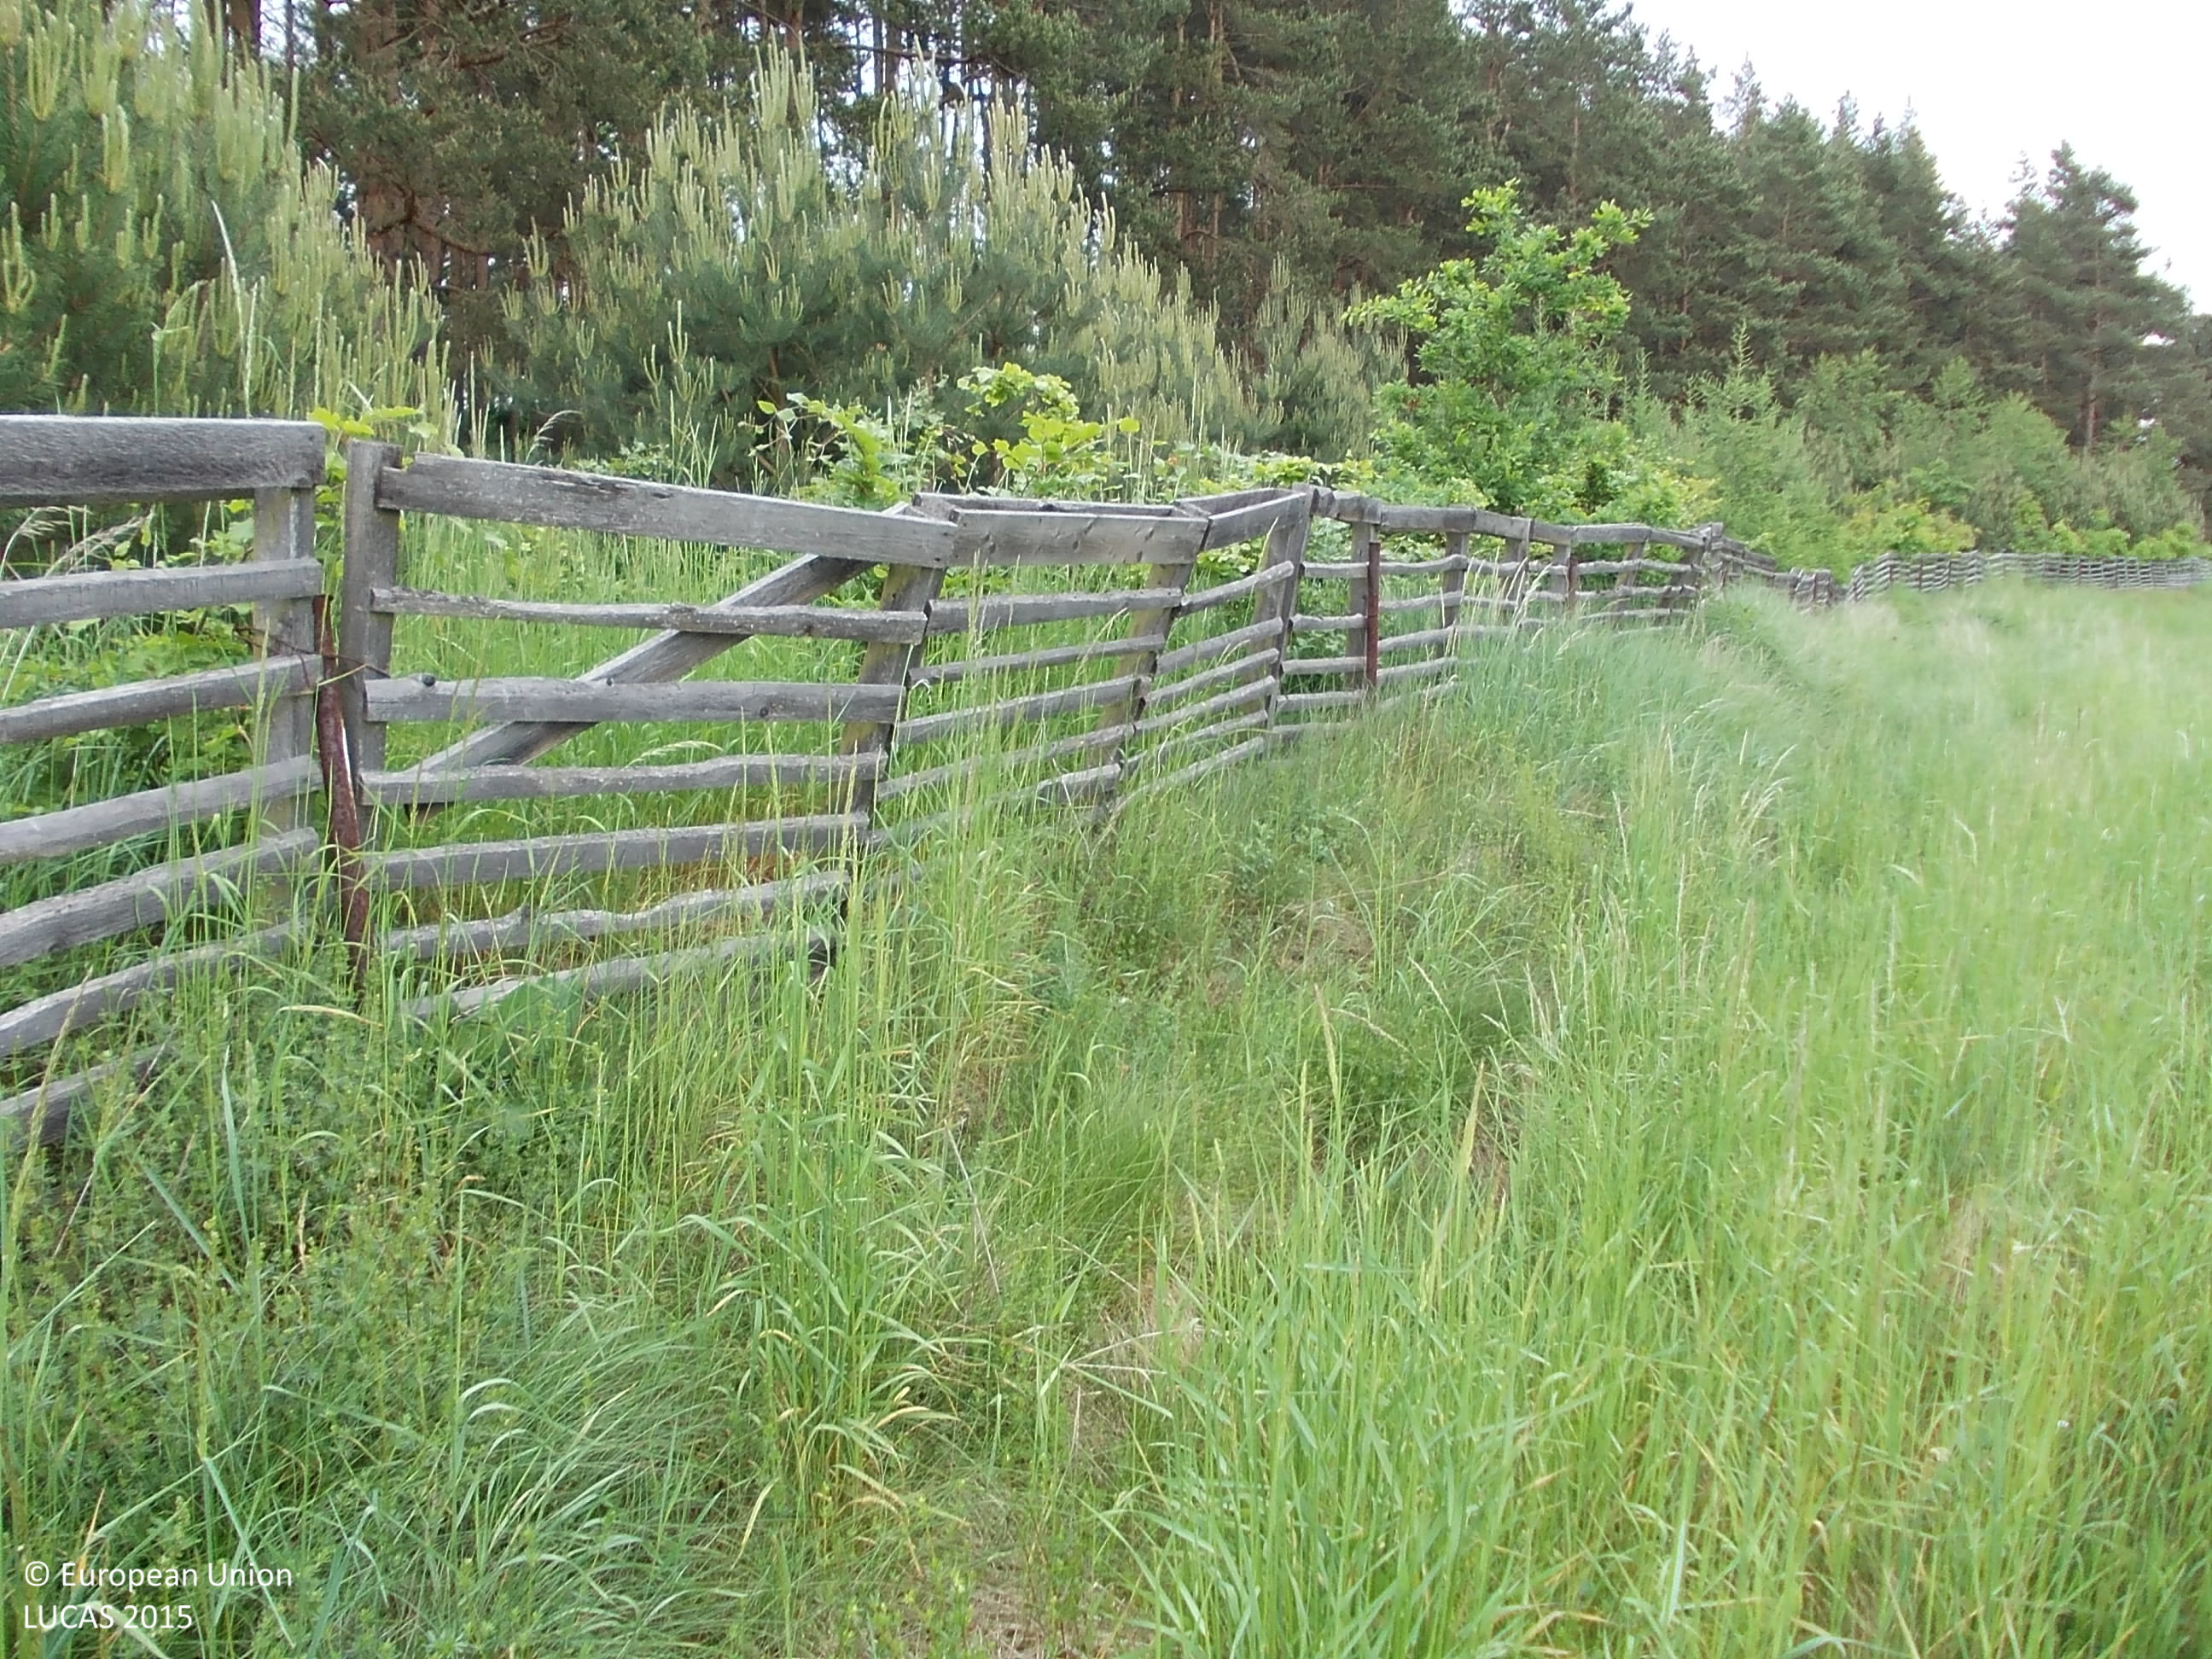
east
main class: Grassland
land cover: Grassland without tree/shrub cover
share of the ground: > 75 %
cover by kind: herbaceous plants 100 %
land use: Semi-natural and natural areas not in use
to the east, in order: Grassland without tree/shrub cover; Fences; Other mixed woodland; Fences; Pine dominated coniferous woodland; Shrubland without tree cover; Fences; Grassland without tree/shrub cover; Fences; Grass margins; Barley
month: May
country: CZ
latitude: 49.3652
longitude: 13.7872
